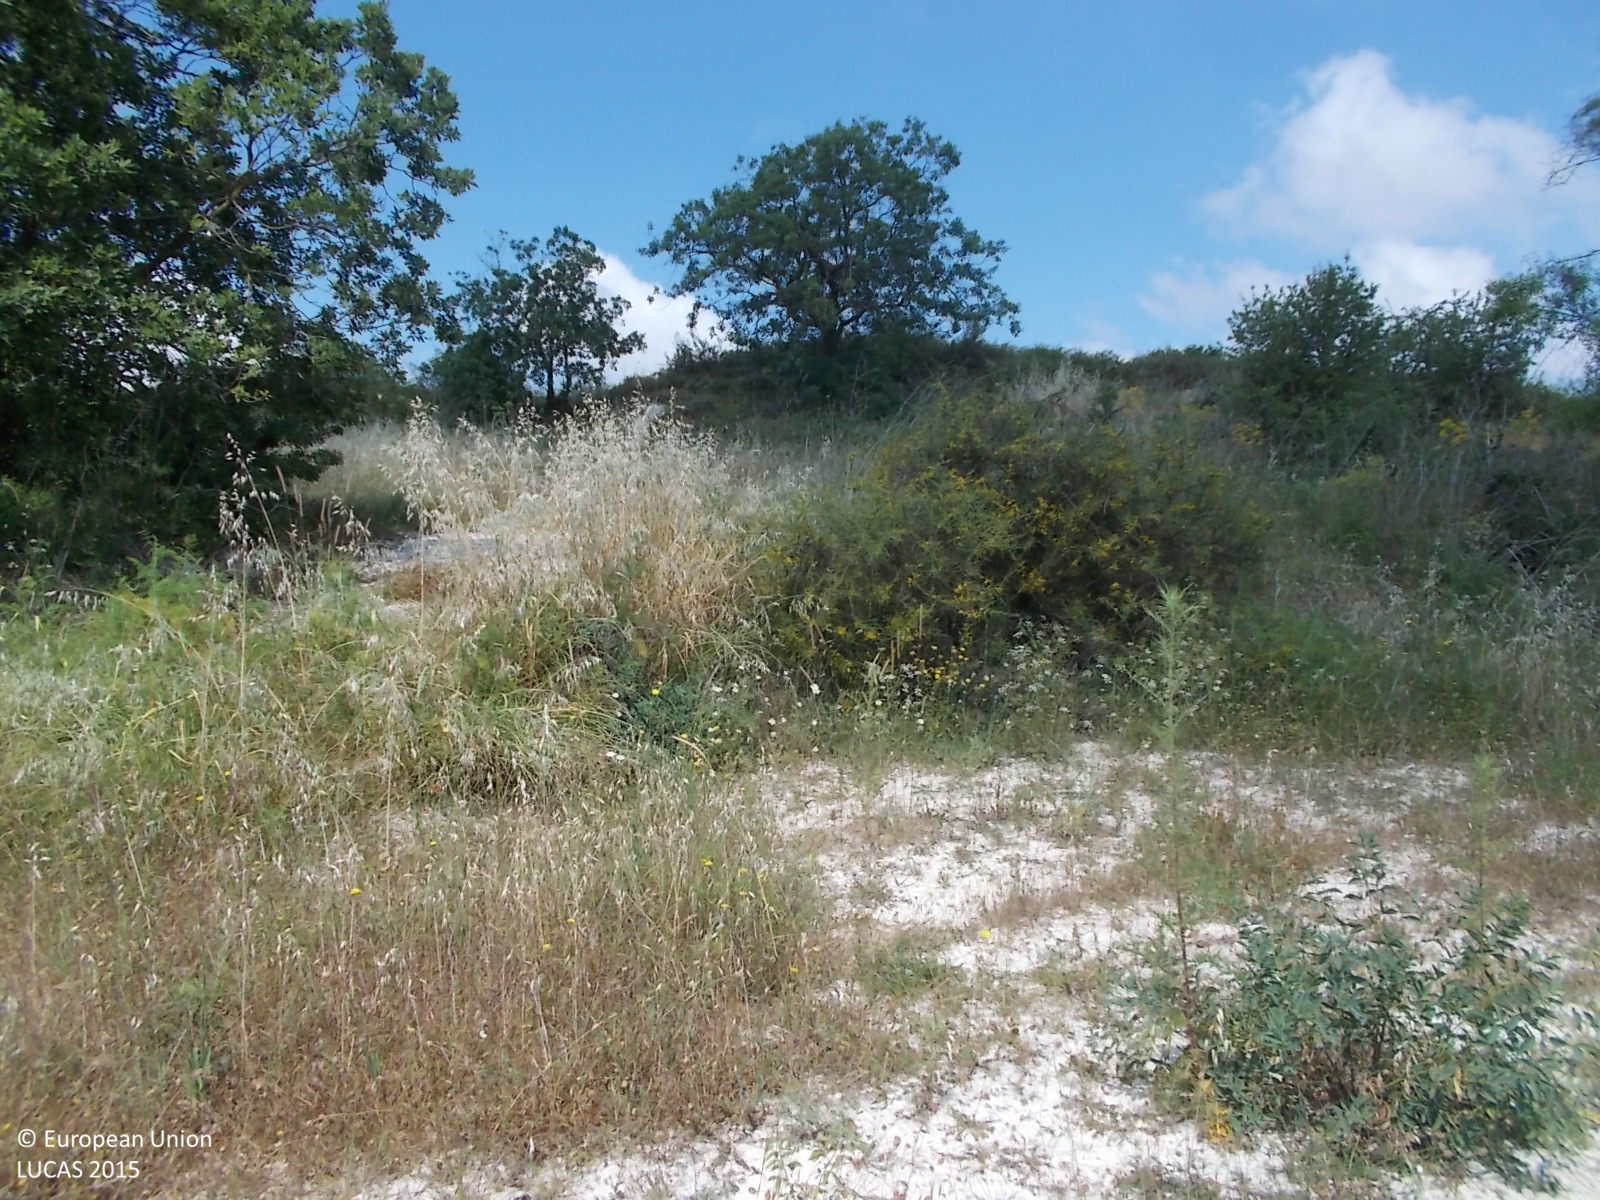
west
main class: Grassland
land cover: Grassland with sparse tree/shrub cover
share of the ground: 50 - 75 %
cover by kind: herbaceous plants 55 %, unconsolidated bare surface 40 %, broadleaved forest trees 5 %
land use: Semi-natural and natural areas not in use
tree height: > 5 m
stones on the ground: 25 - 50 %
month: May
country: CY
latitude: 34.9151
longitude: 32.4460
